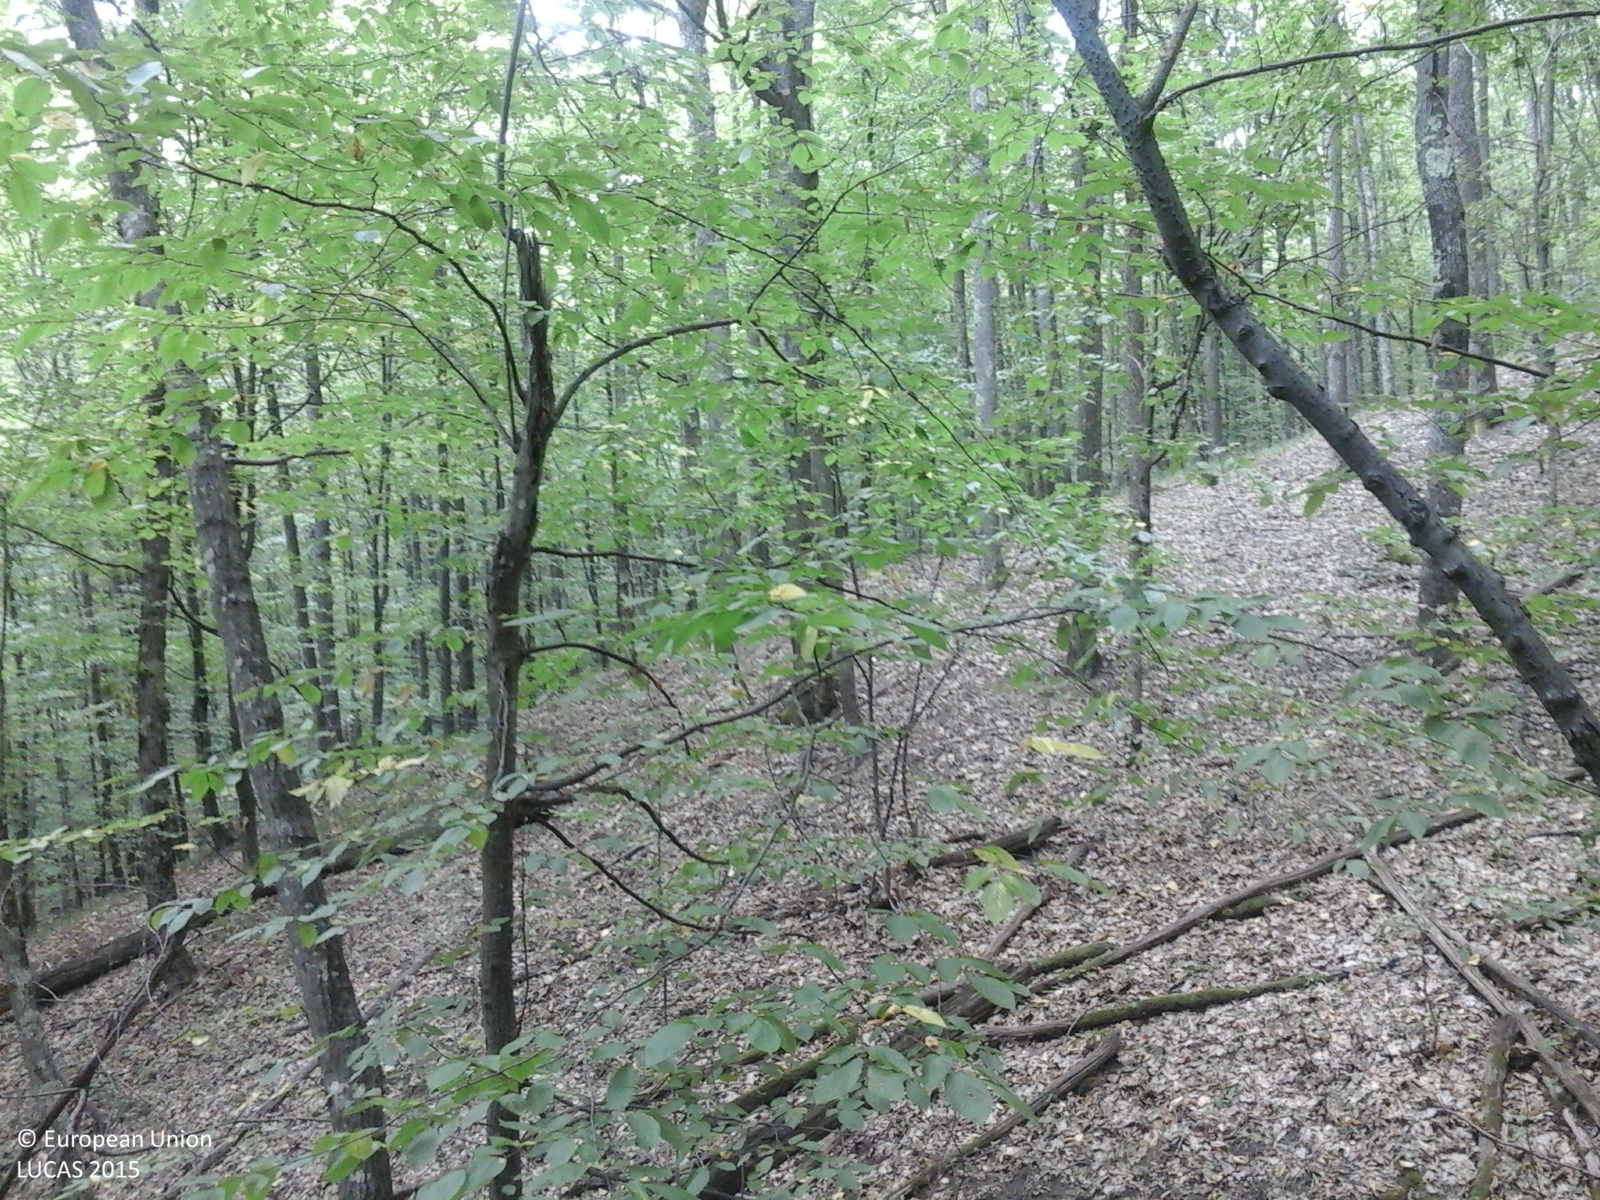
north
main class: Woodland
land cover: Broadleaved woodland
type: mesophytic deciduous forest
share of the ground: > 75 %
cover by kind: broadleaved forest trees 100 %
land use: Forestry
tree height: > 5 m
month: August
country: RO
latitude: 44.7165
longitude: 23.8332
